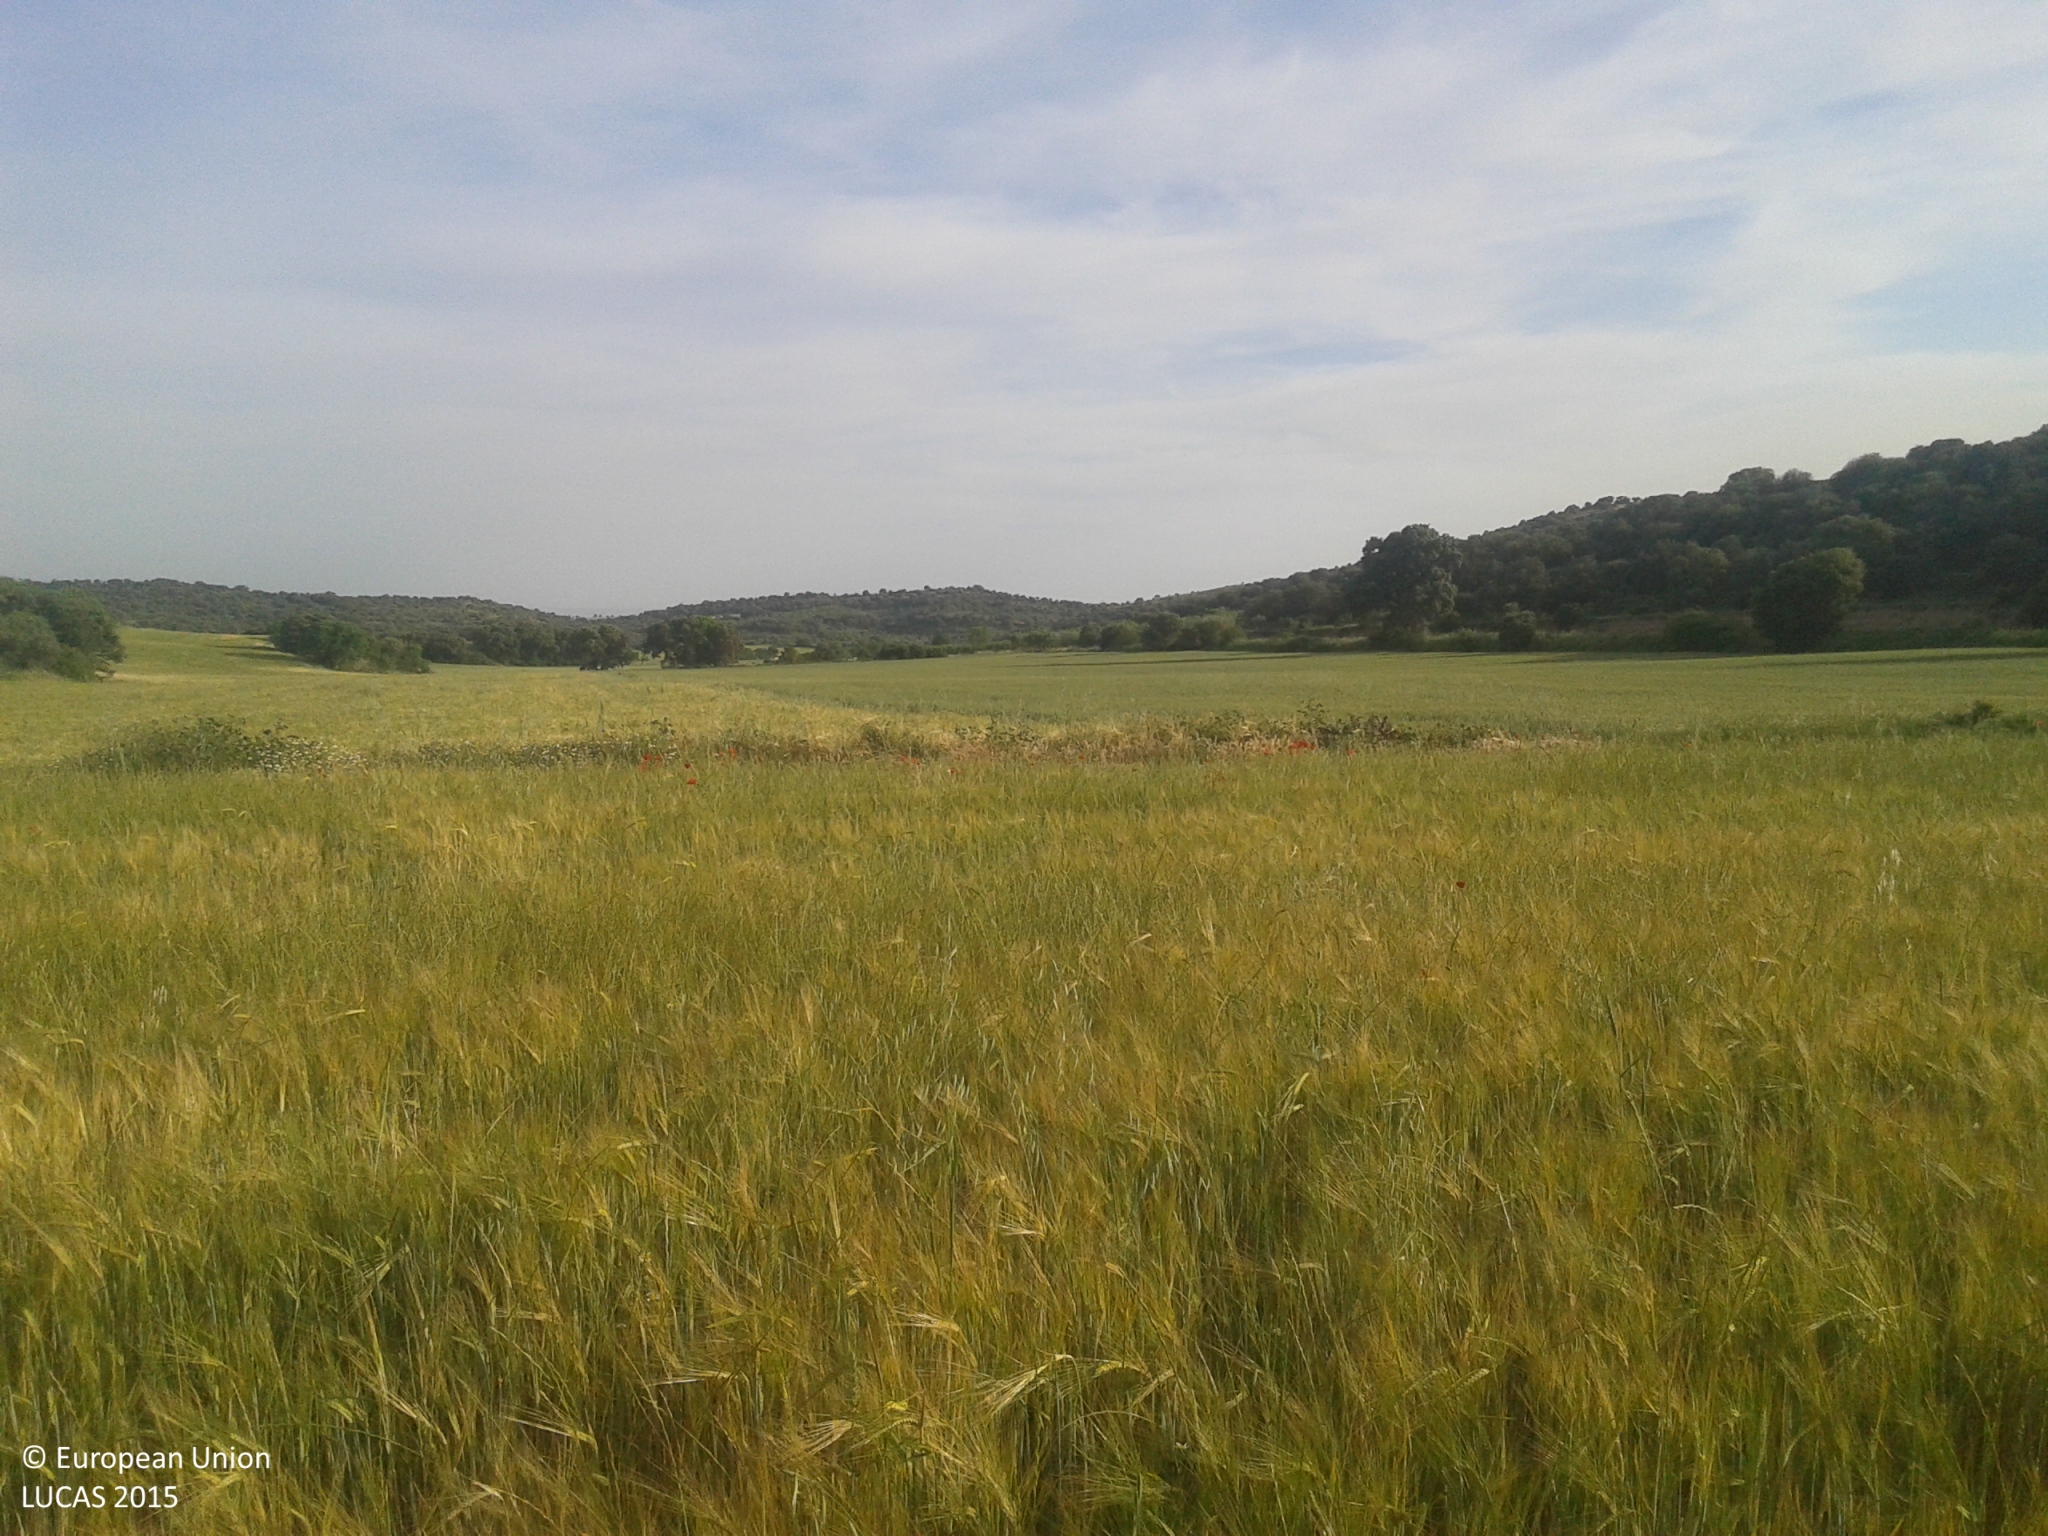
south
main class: Cropland
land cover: Rye
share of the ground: > 75 %
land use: Agriculture (excluding fallow land and kitchen gardens)
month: May
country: ES
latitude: 41.8573
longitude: 0.6503
